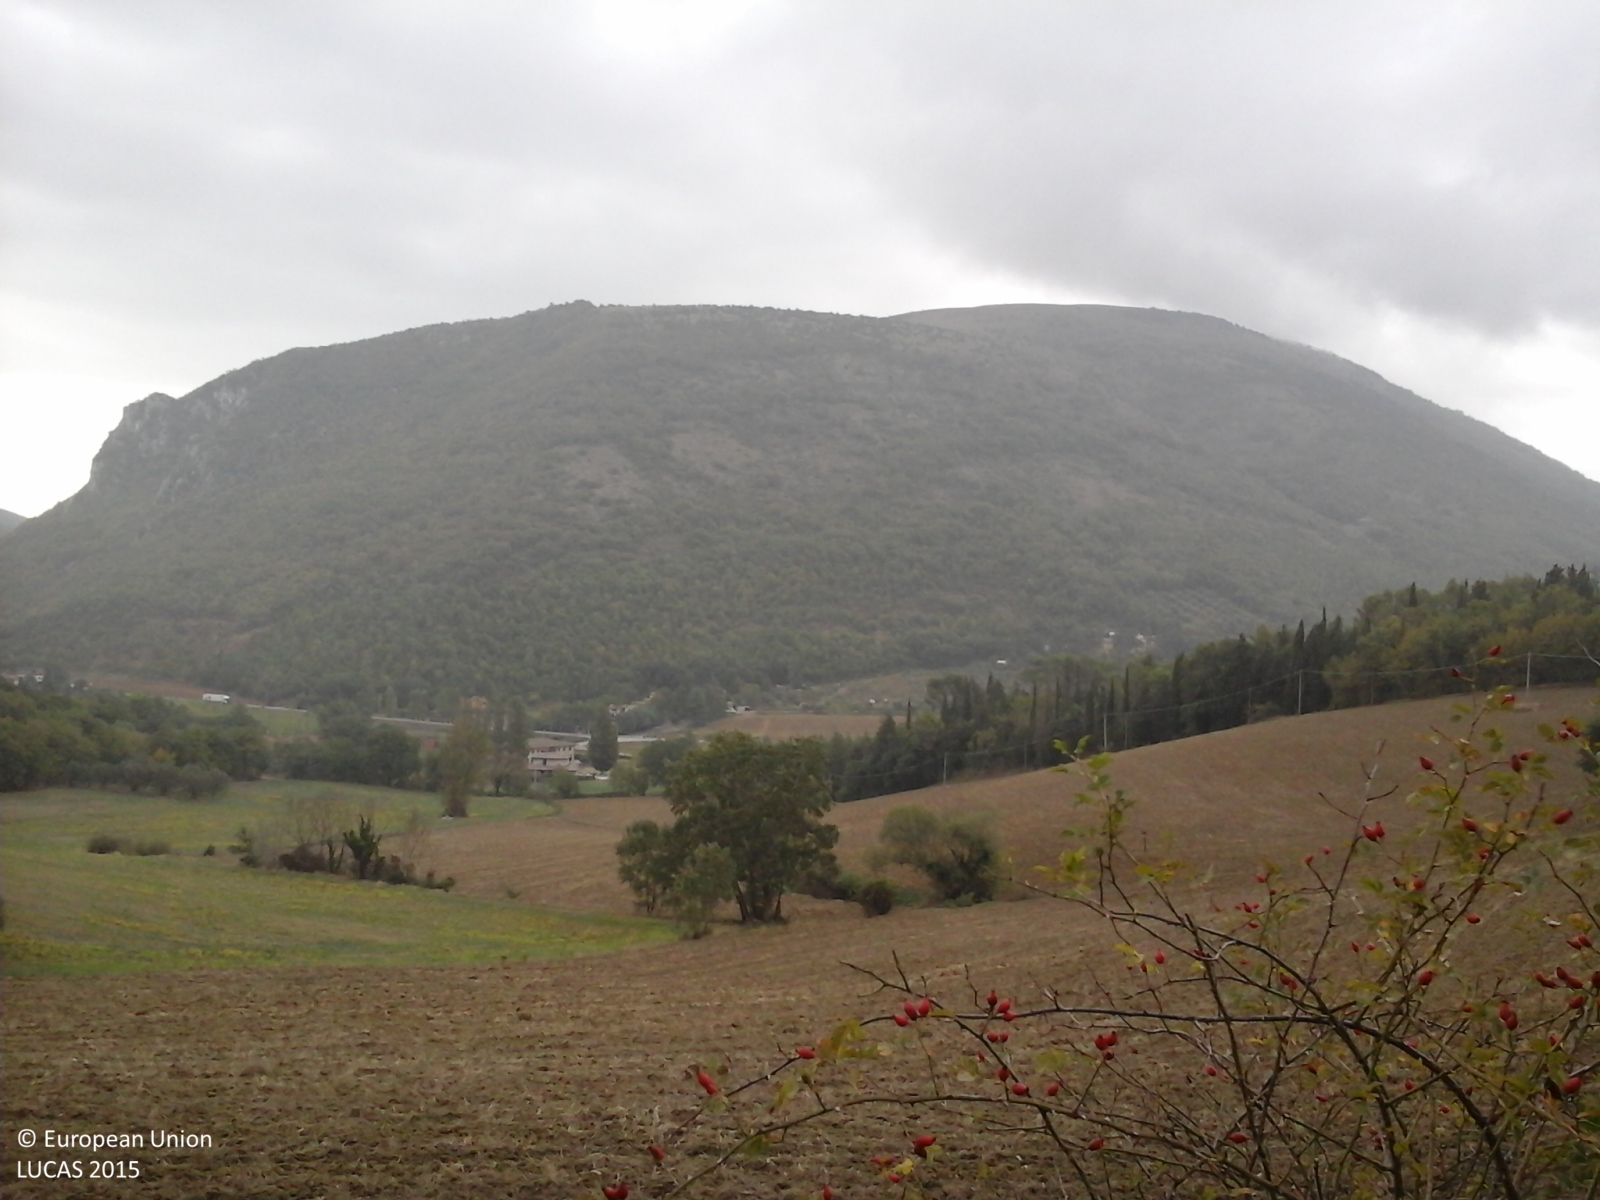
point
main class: Shrubland
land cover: Shrubland with sparse tree cover
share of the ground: > 75 %
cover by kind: shrubs 60 %, herbaceous plants 35 %, broadleaved forest trees 5 %
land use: Agriculture (excluding fallow land and kitchen gardens)
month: October
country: IT
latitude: 43.2235
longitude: 12.3203
